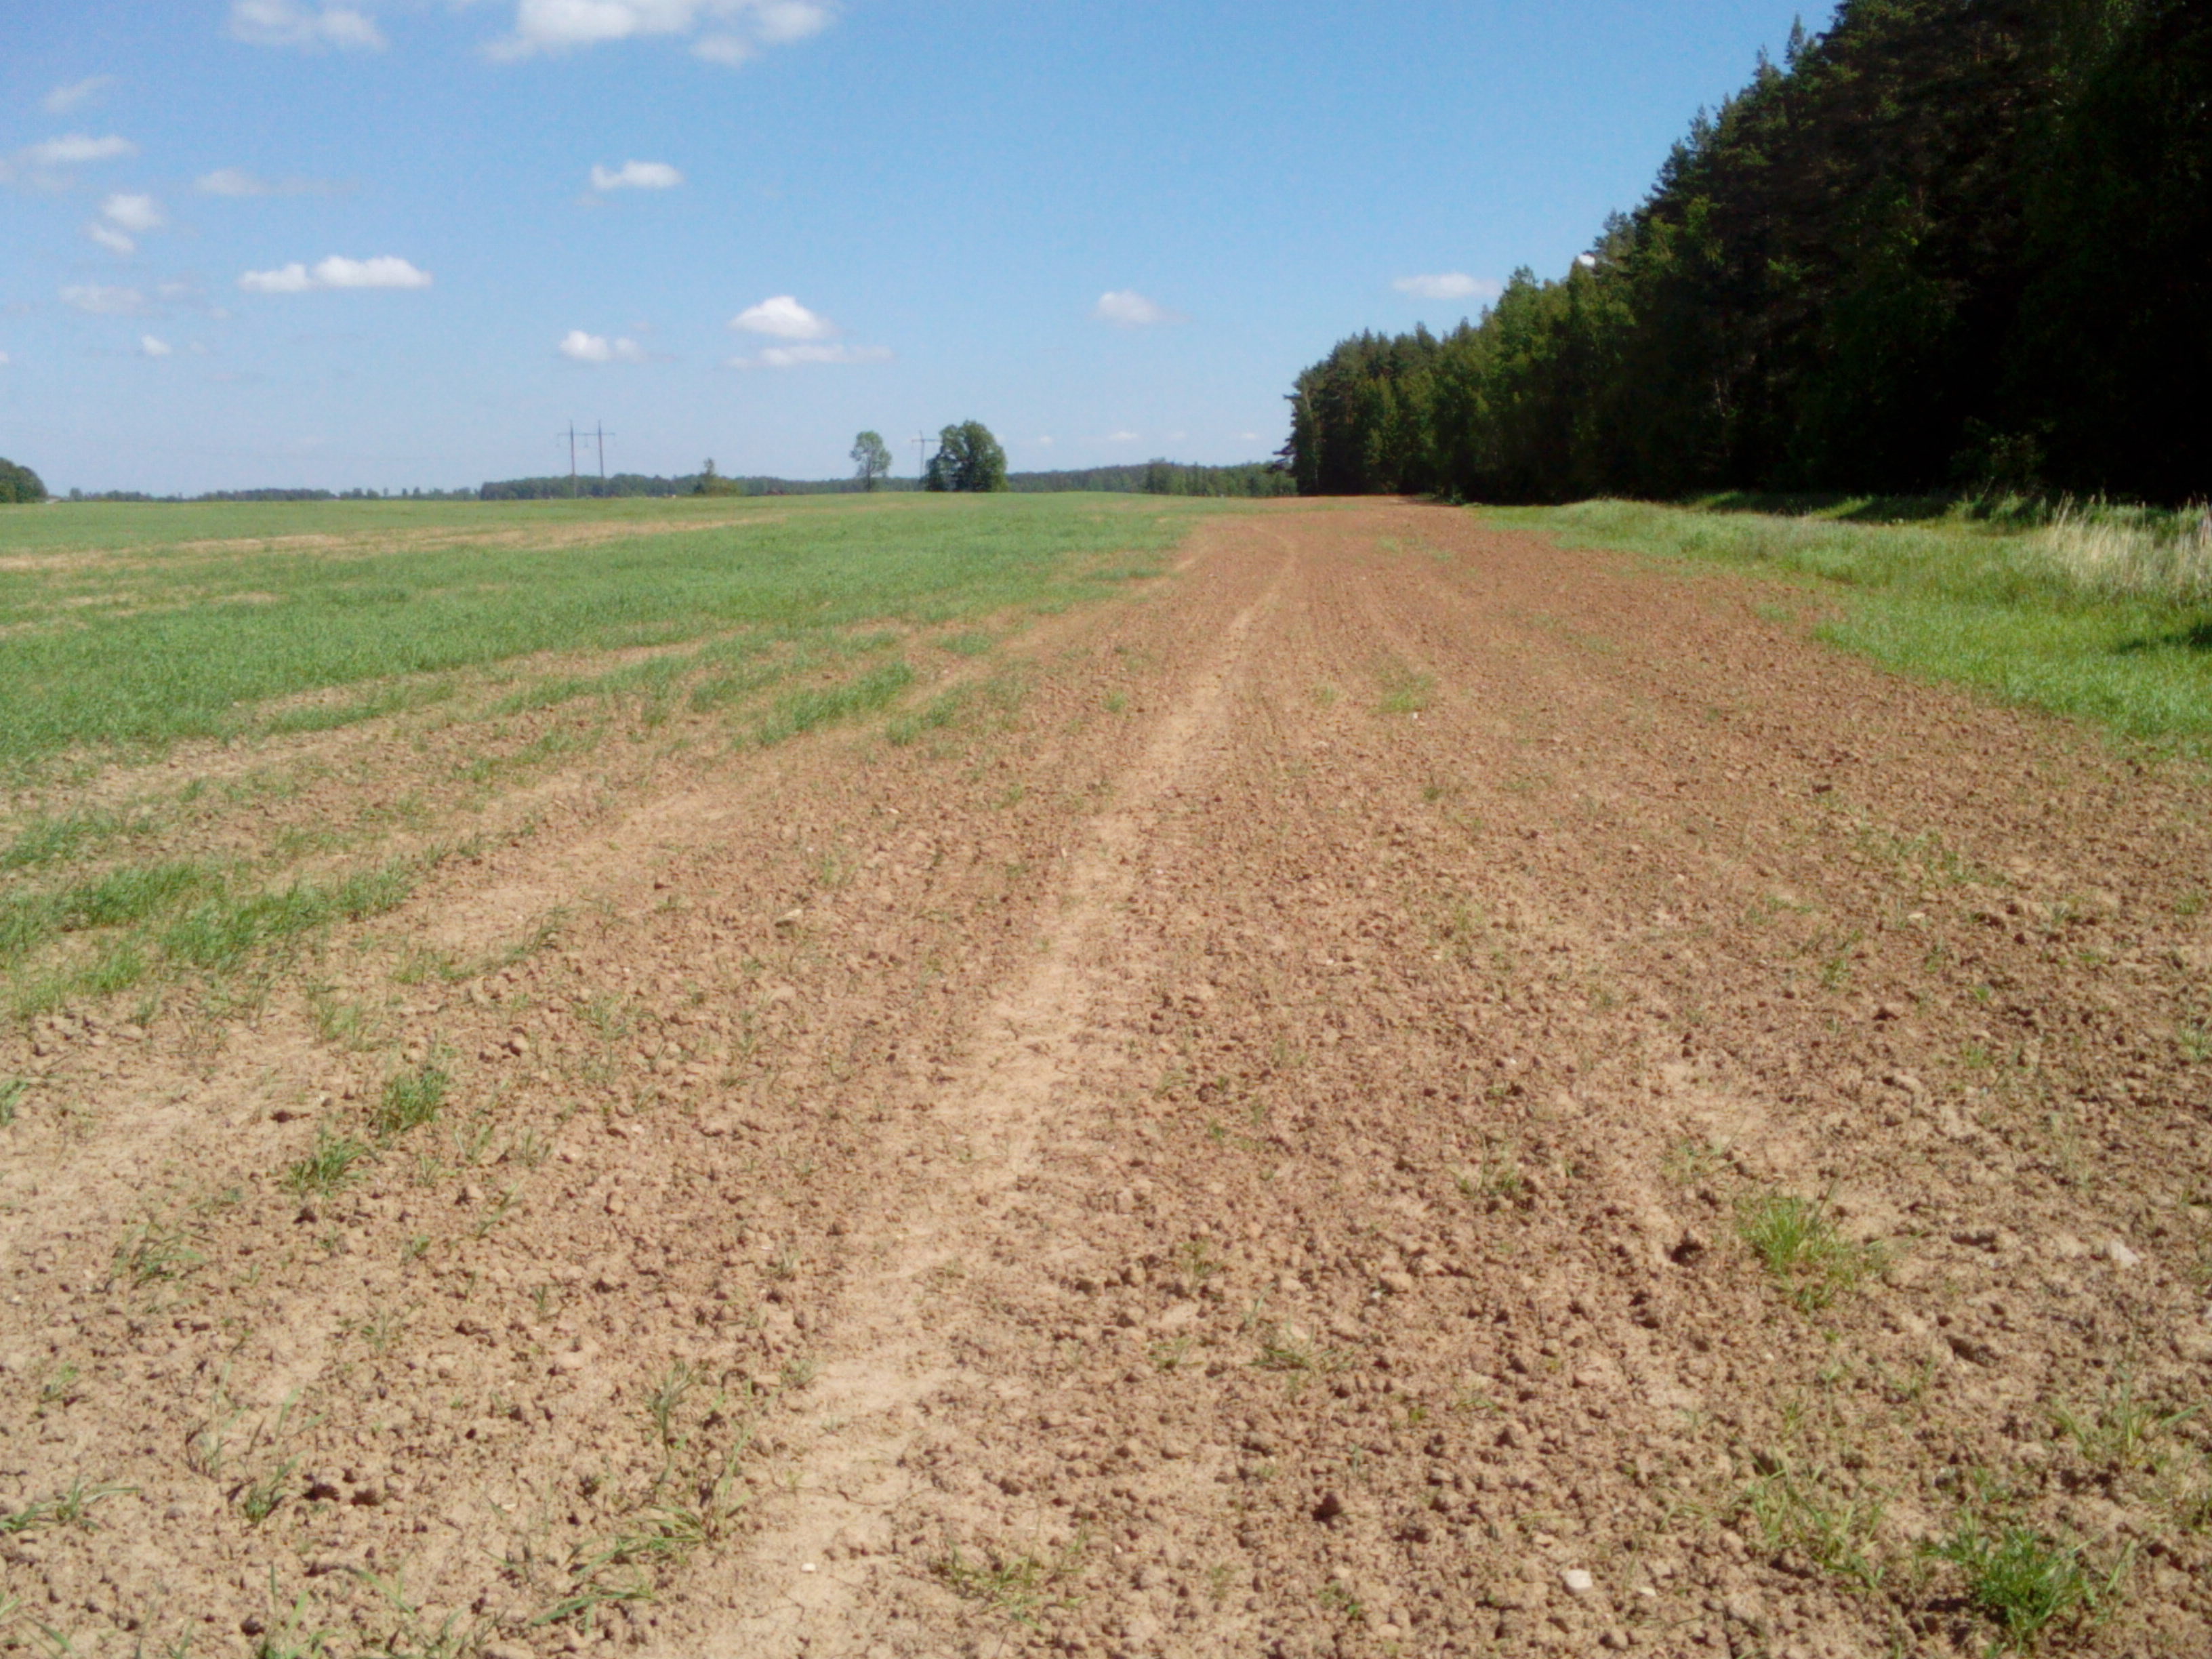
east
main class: Grassland
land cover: Spontaneously vegetated surfaces
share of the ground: < 10 %
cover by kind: unconsolidated bare surface 90 %, herbaceous plants 10 %
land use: Fallow land
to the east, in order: Spontaneously vegetated surfaces; Other bare soil; Spontaneously vegetated surfaces
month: June
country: LV
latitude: 56.6556
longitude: 22.2376
